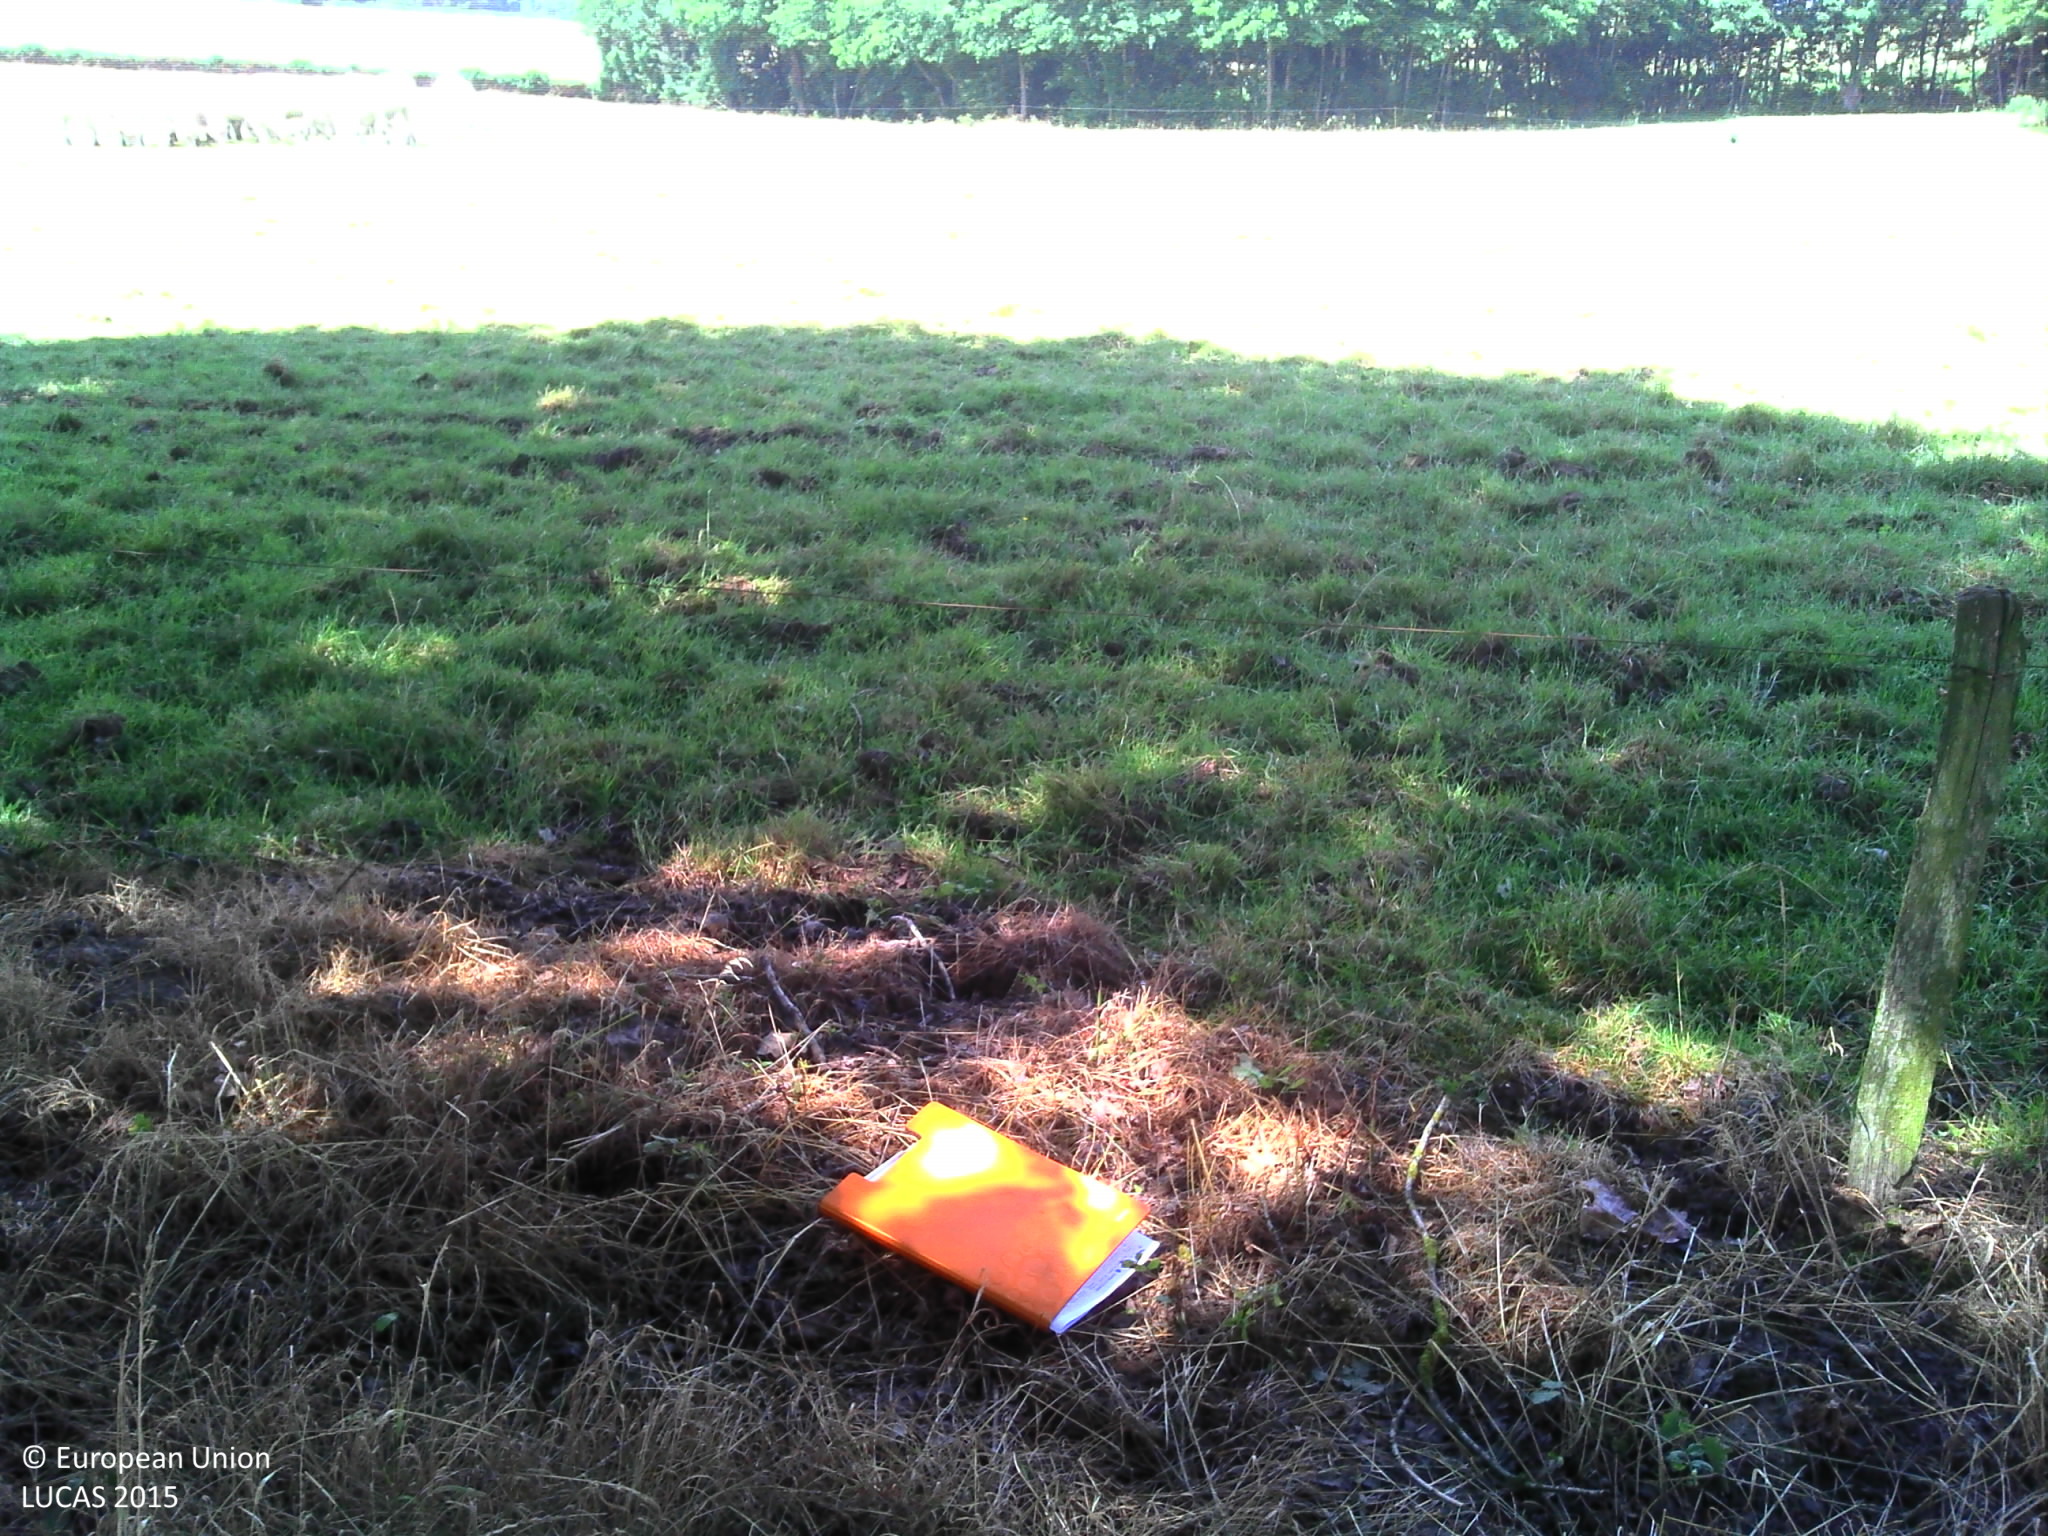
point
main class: Grassland
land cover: Grassland without tree/shrub cover
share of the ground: > 75 %
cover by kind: herbaceous plants 100 %
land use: Agriculture (excluding fallow land and kitchen gardens)
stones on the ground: < 10 %
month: June
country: FR
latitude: 47.4366
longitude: 2.6605
